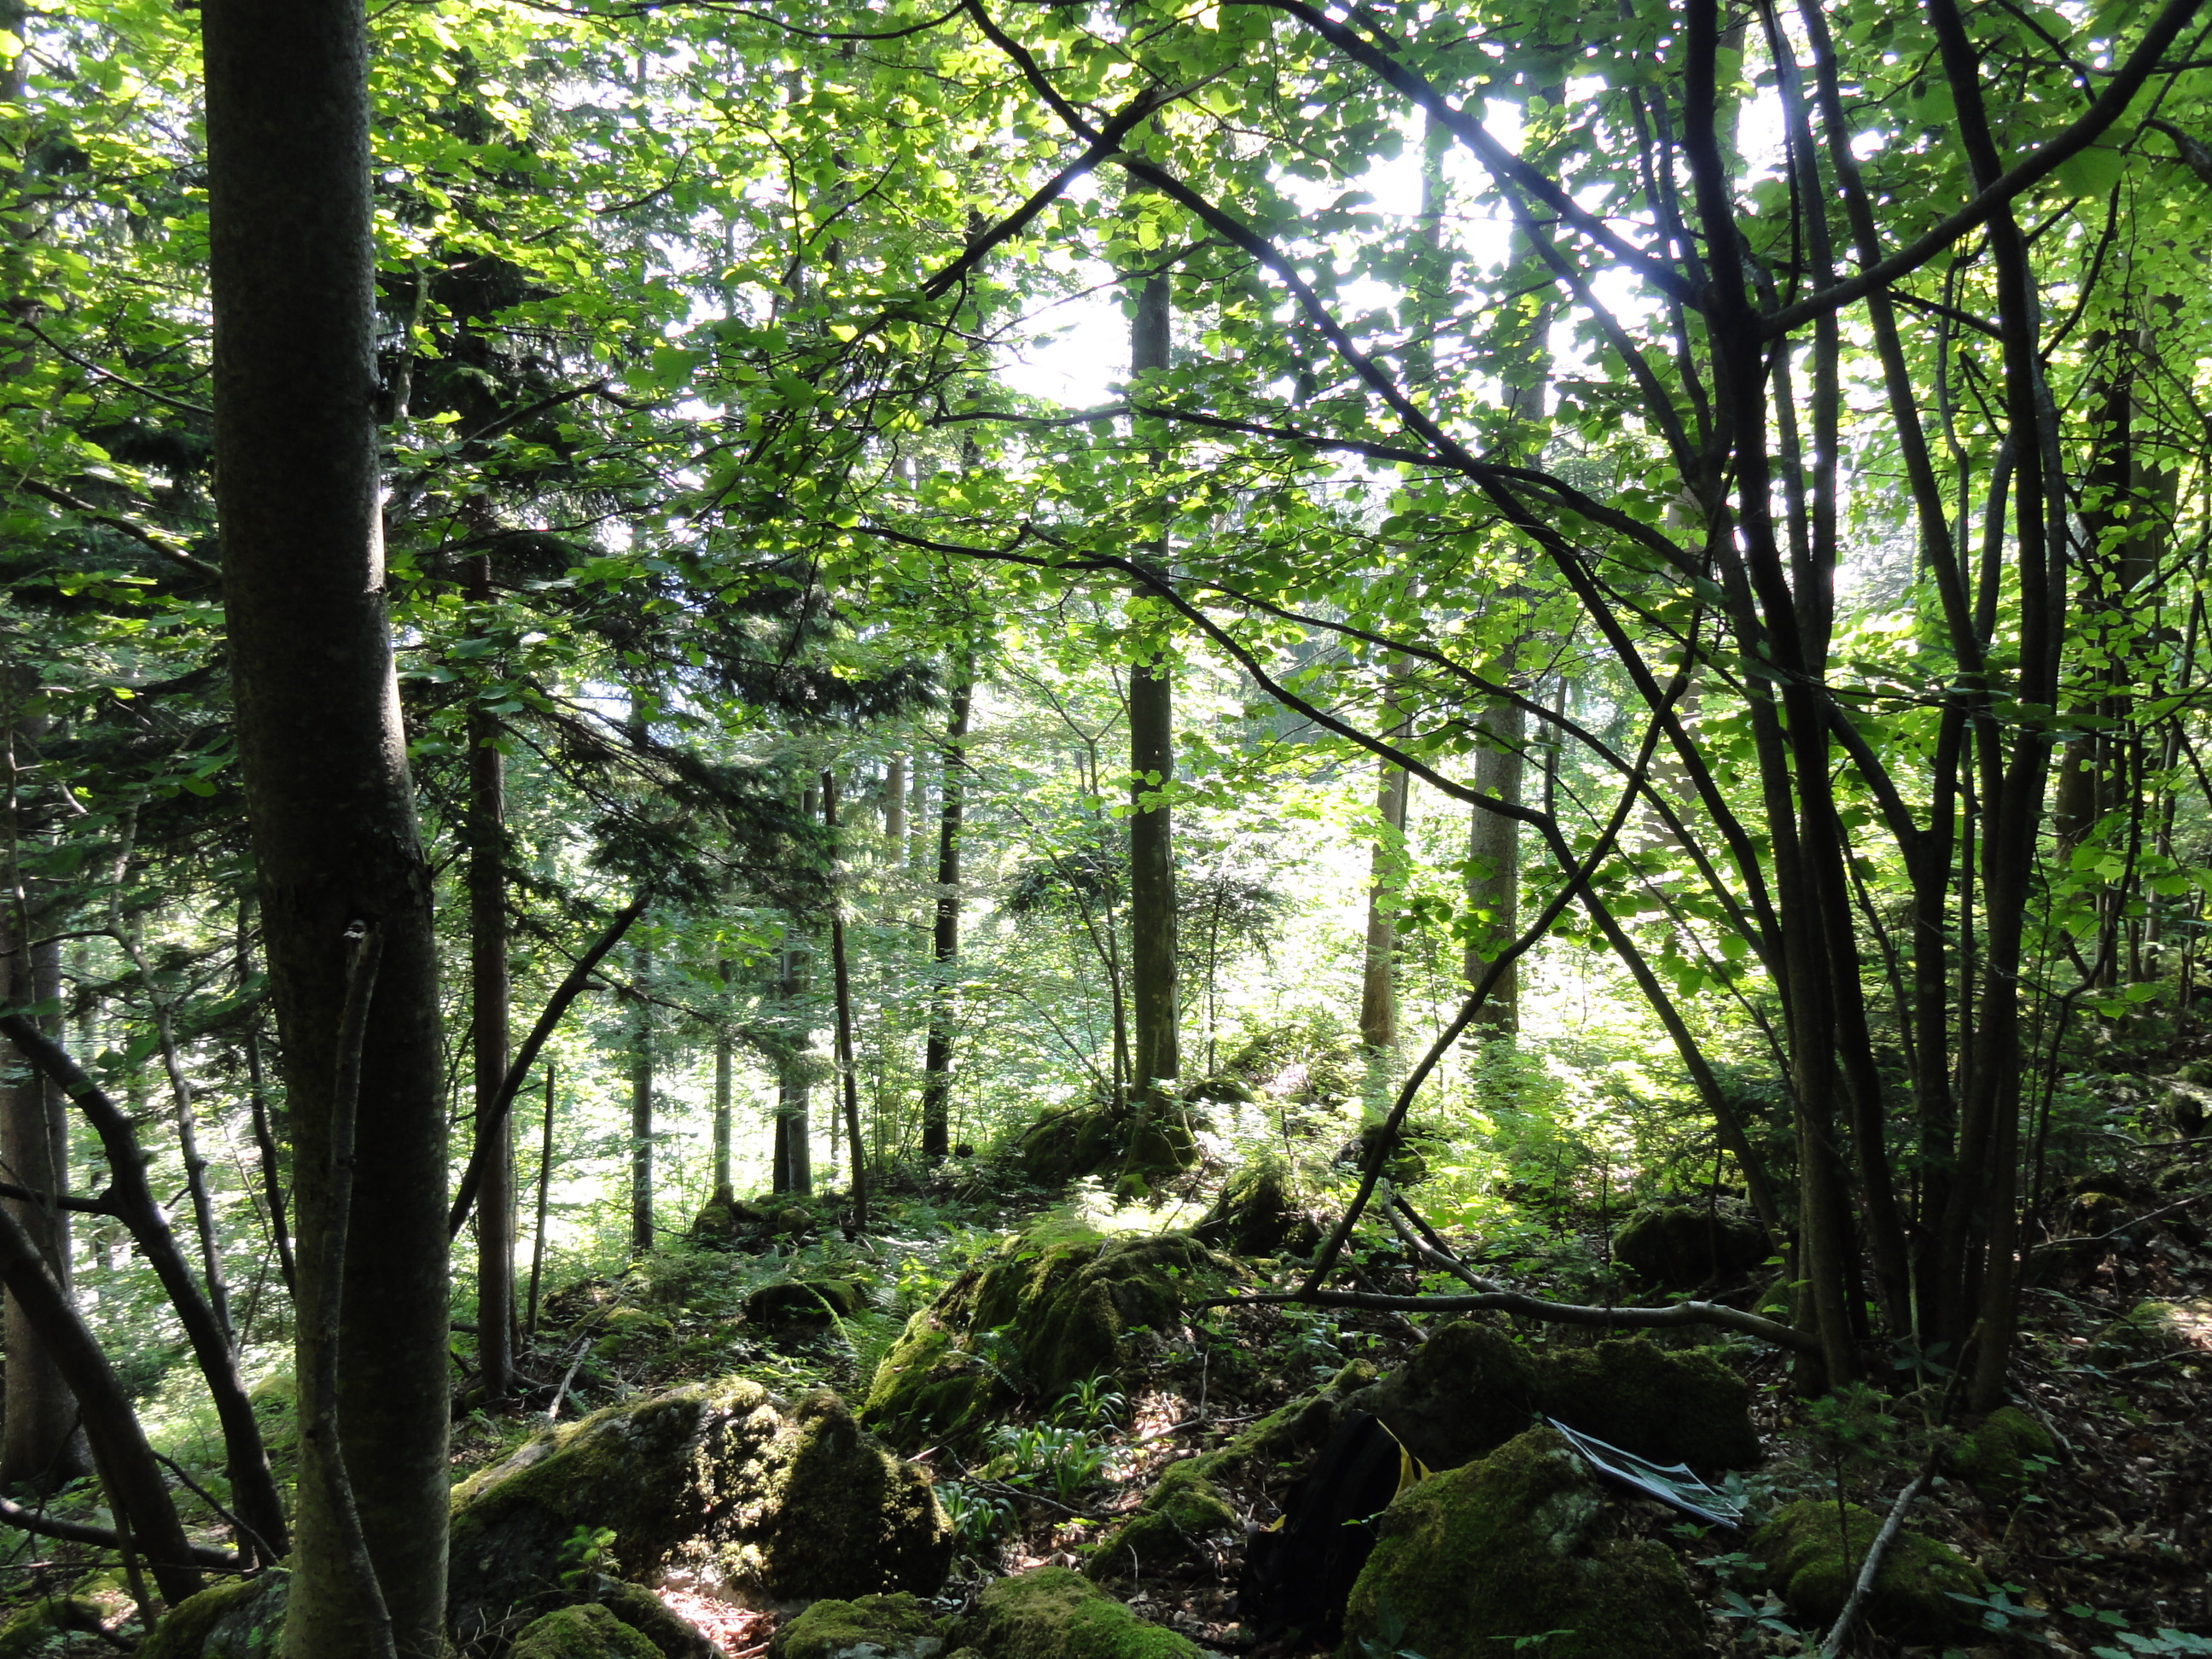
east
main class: Woodland
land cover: Spruce dominated mixed woodland
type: mountainous beech forest
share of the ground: > 75 %
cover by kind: broadleaved forest trees 70 %, coniferous forest trees 30 %
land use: Forestry
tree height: > 5 m
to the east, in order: Spruce dominated mixed woodland; Shrubland with sparse tree cover; Spruce dominated mixed woodland; Shrubland with sparse tree cover; Tracks; Spruce dominated mixed woodland; Tracks; Spruce dominated mixed woodland; Tracks; Spruce dominated mixed woodland; Spruce dominated coniferous woodland
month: June
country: SI
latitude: 46.2767
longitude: 14.8637
